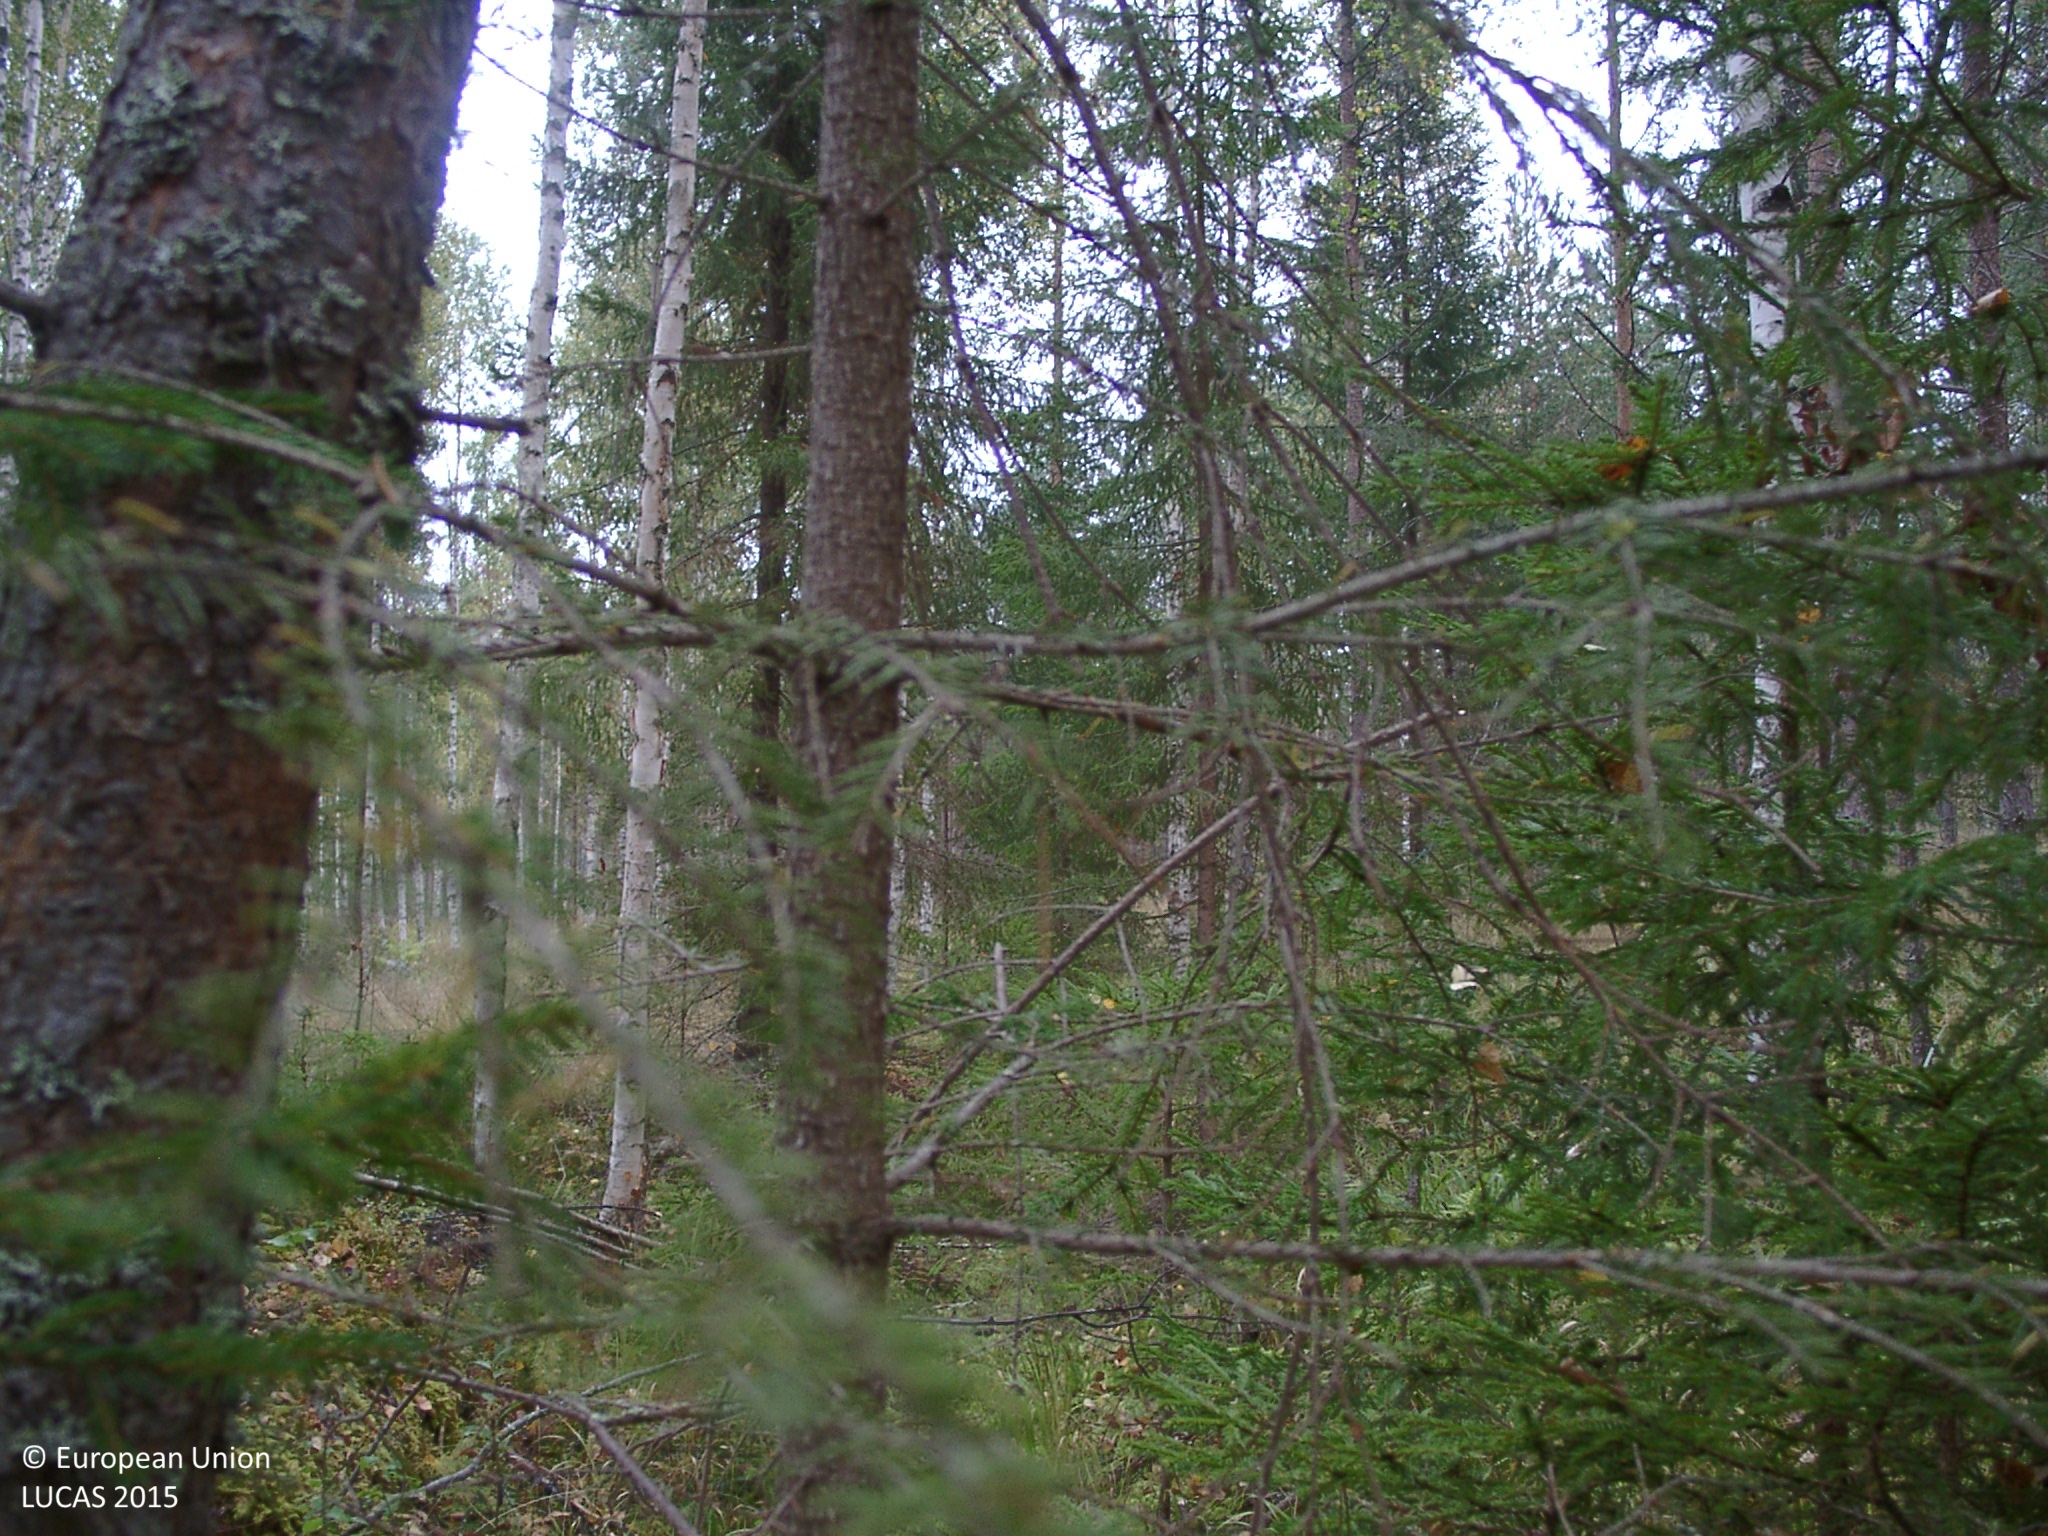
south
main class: Woodland
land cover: Pine dominated mixed woodland
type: boreal forest
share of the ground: 50 - 75 %
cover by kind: coniferous forest trees 45 %, herbaceous plants 30 %, broadleaved forest trees 25 %
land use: Forestry
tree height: > 5 m
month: September
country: FI
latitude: 62.7141
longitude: 25.7782
